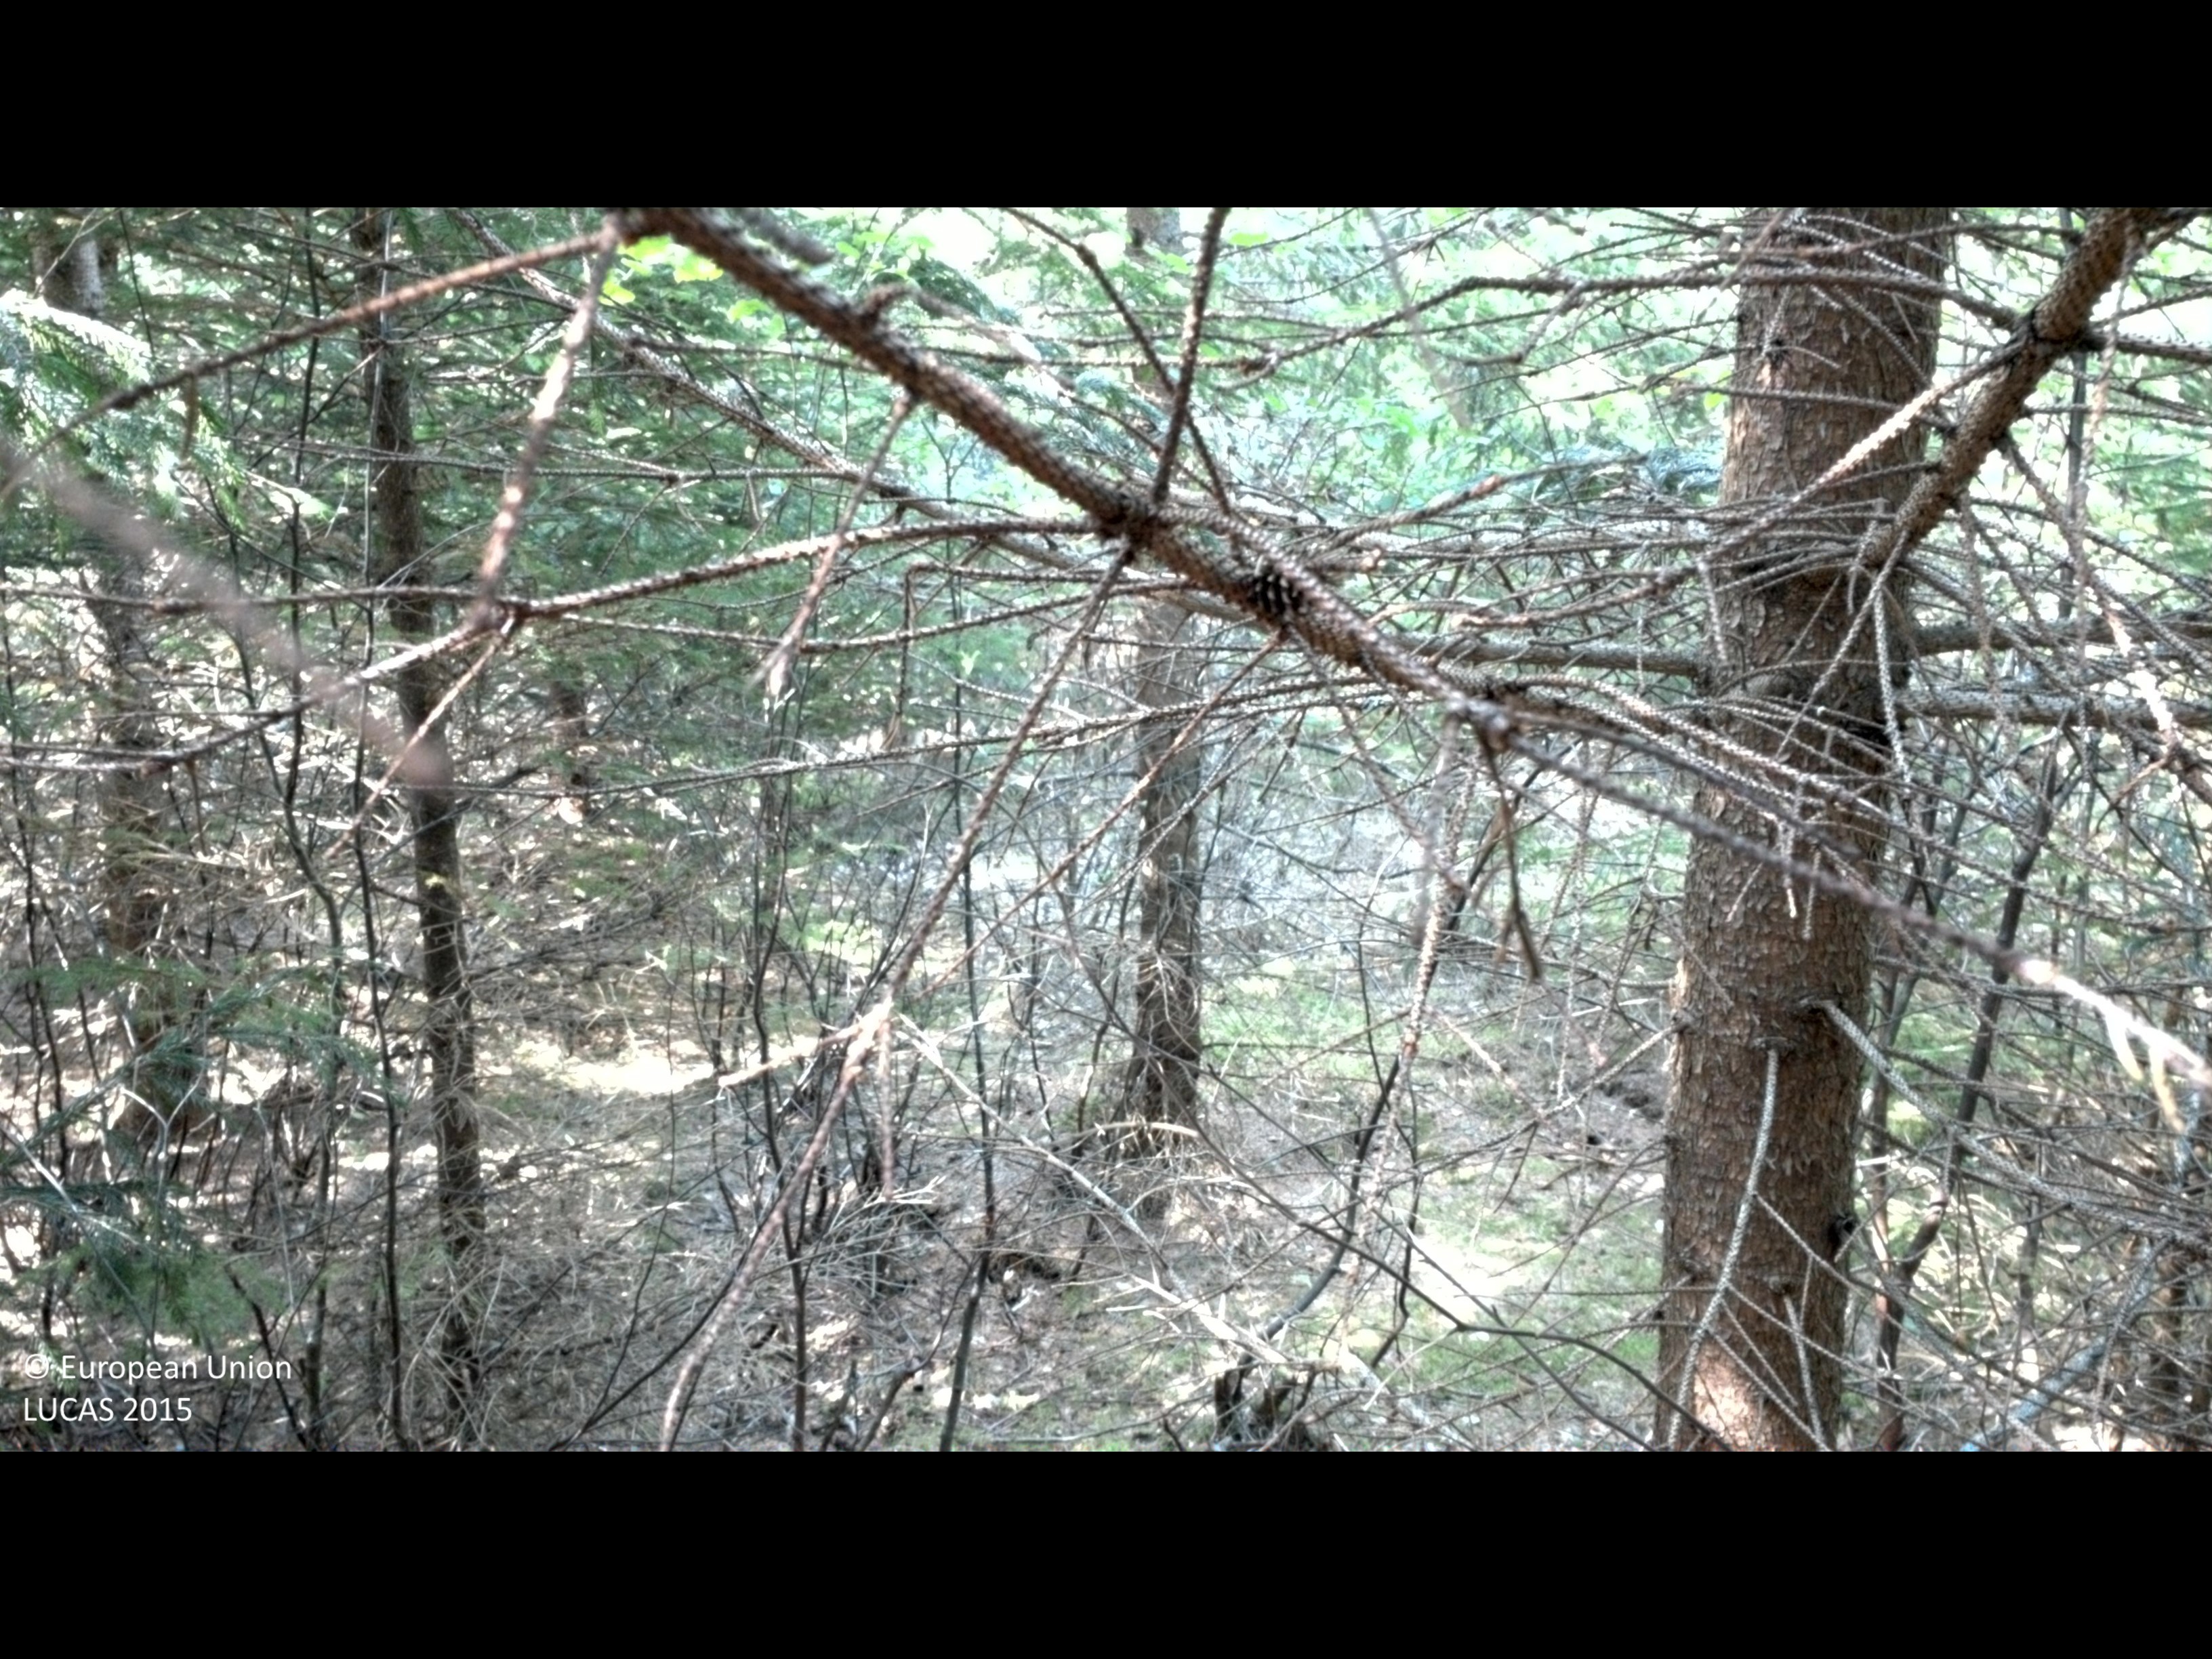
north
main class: Woodland
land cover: Spruce dominated coniferous woodland
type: boreal forest
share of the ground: > 75 %
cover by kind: coniferous forest trees 75 %, broadleaved forest trees 15 %, shrubs 5 %, lichens and mosses 5 %
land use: Forestry
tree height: > 5 m
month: July
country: SE
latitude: 58.3067
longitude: 16.6698
